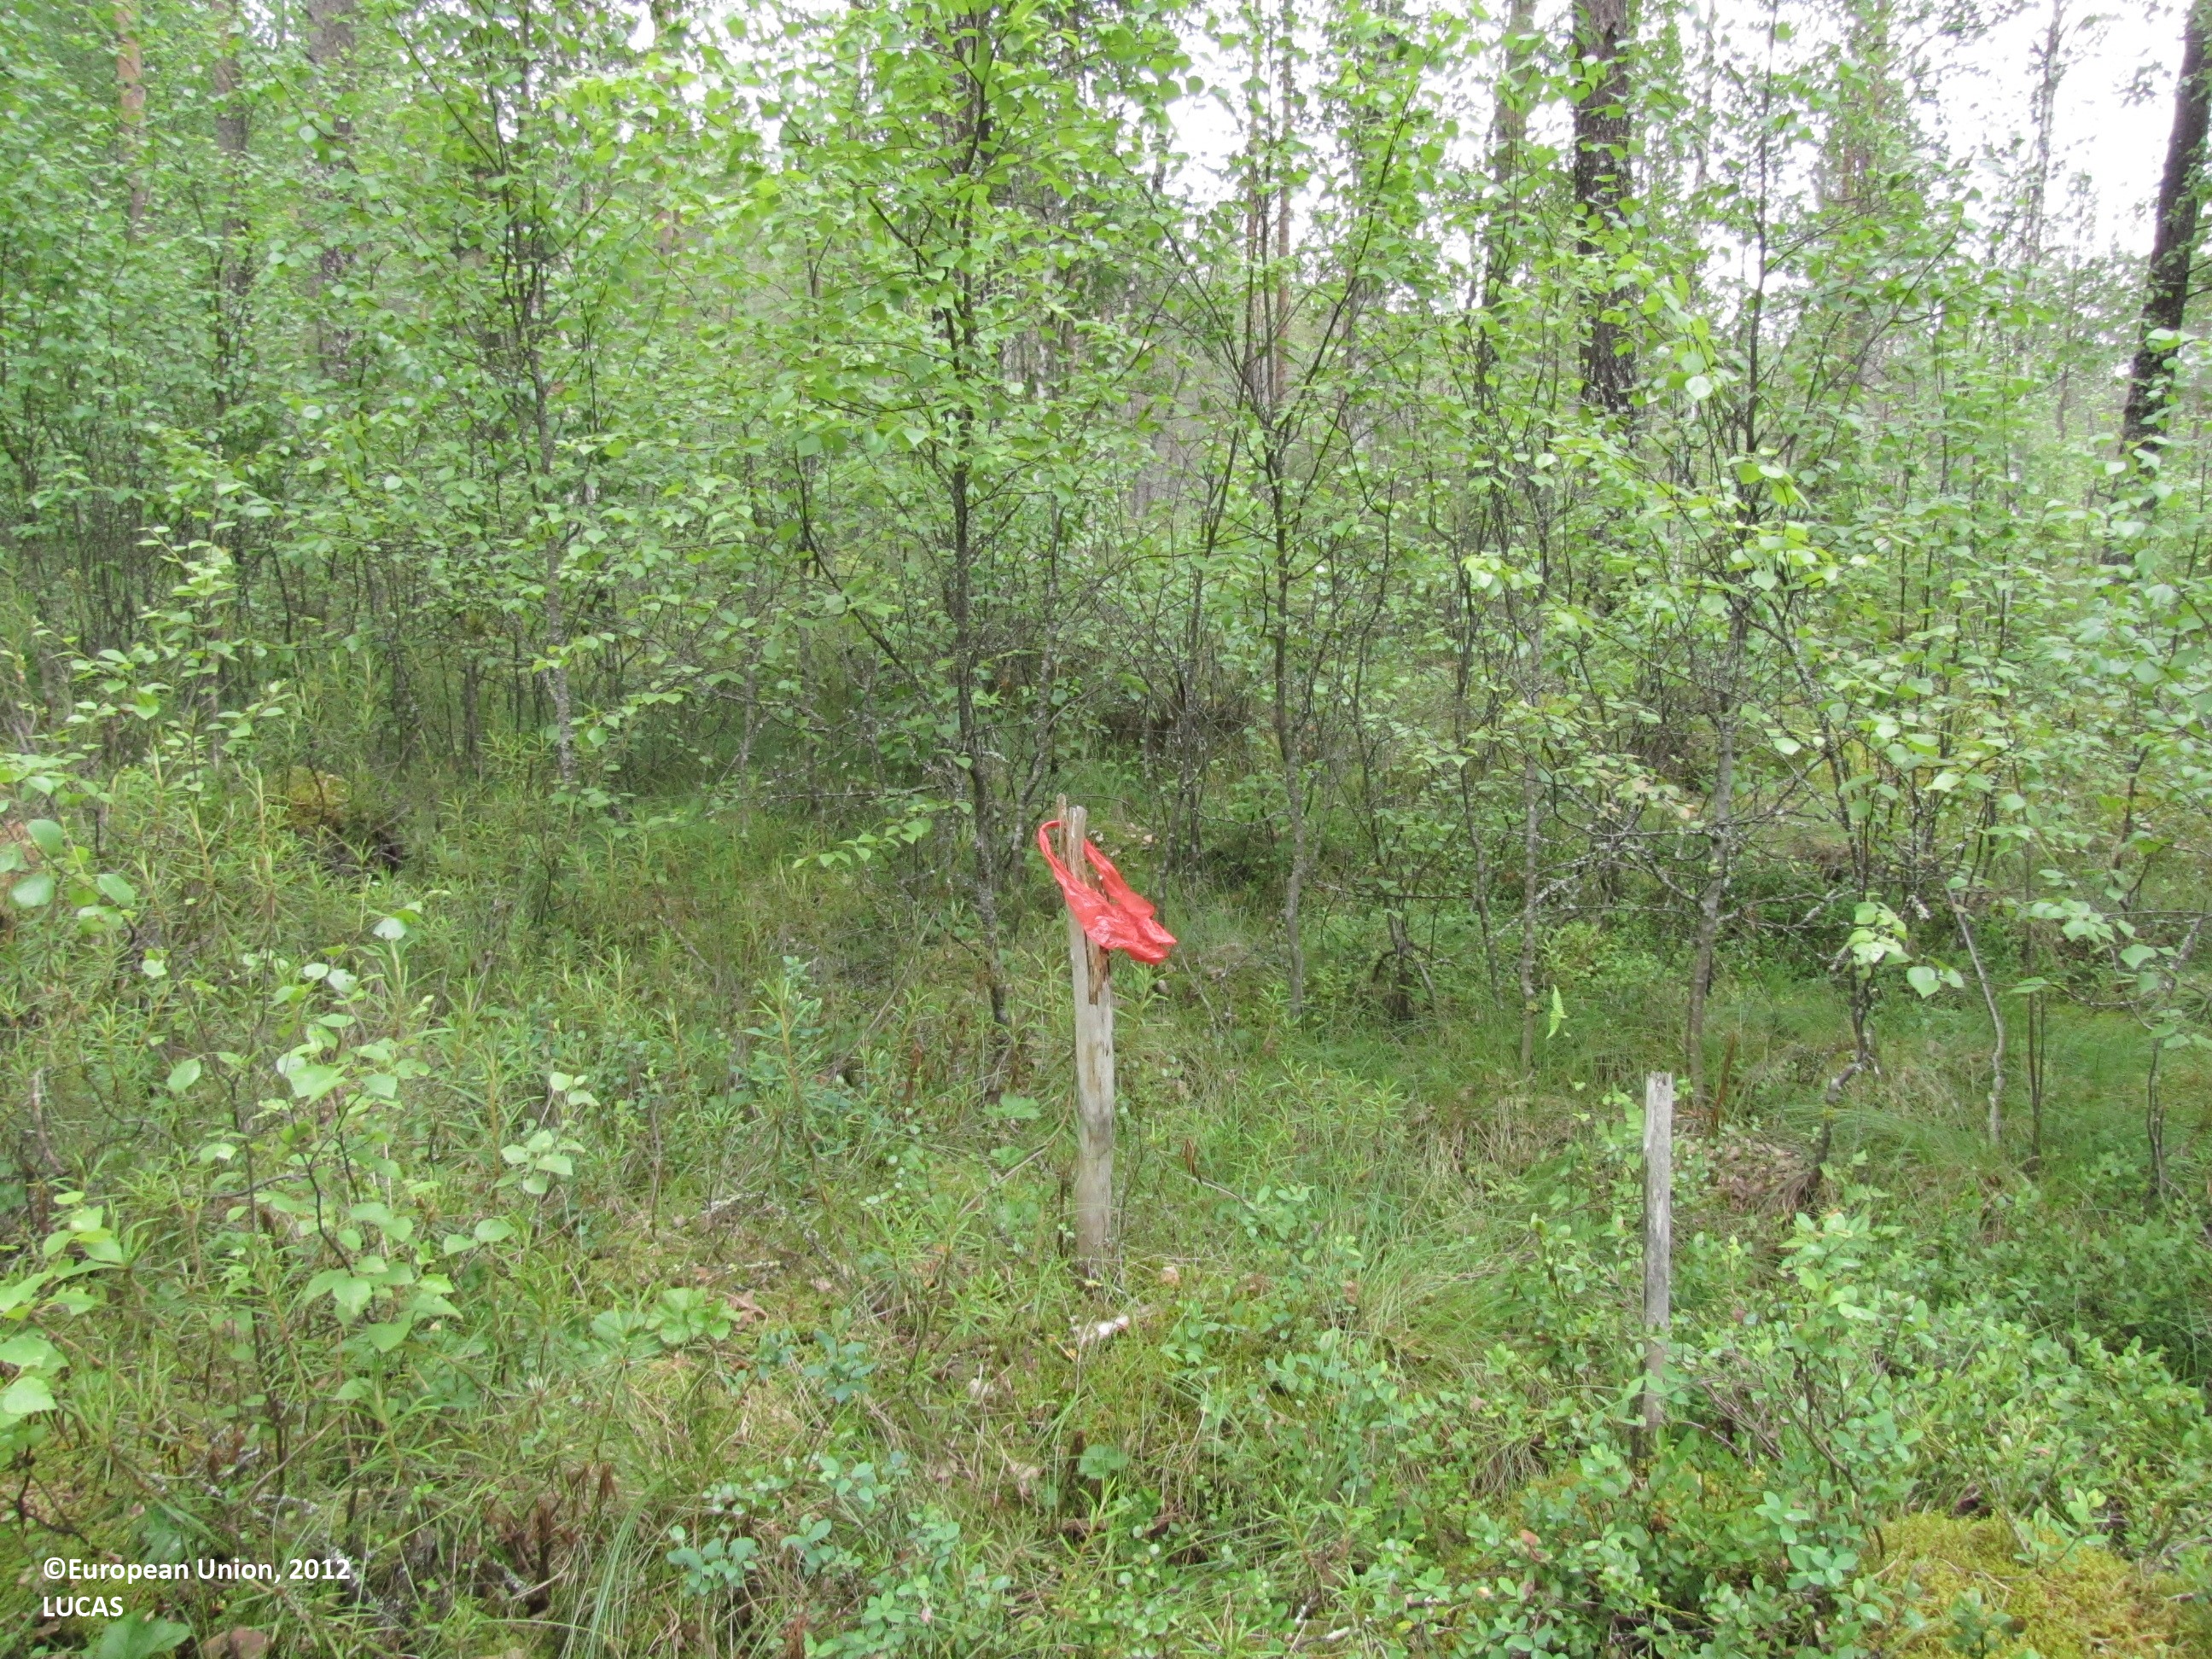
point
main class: Woodland
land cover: Pine dominated coniferous woodland
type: mire and swamp forests
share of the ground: > 75 %
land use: Community services
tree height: > 5 m
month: July
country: FI
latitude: 62.3464
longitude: 23.9277
